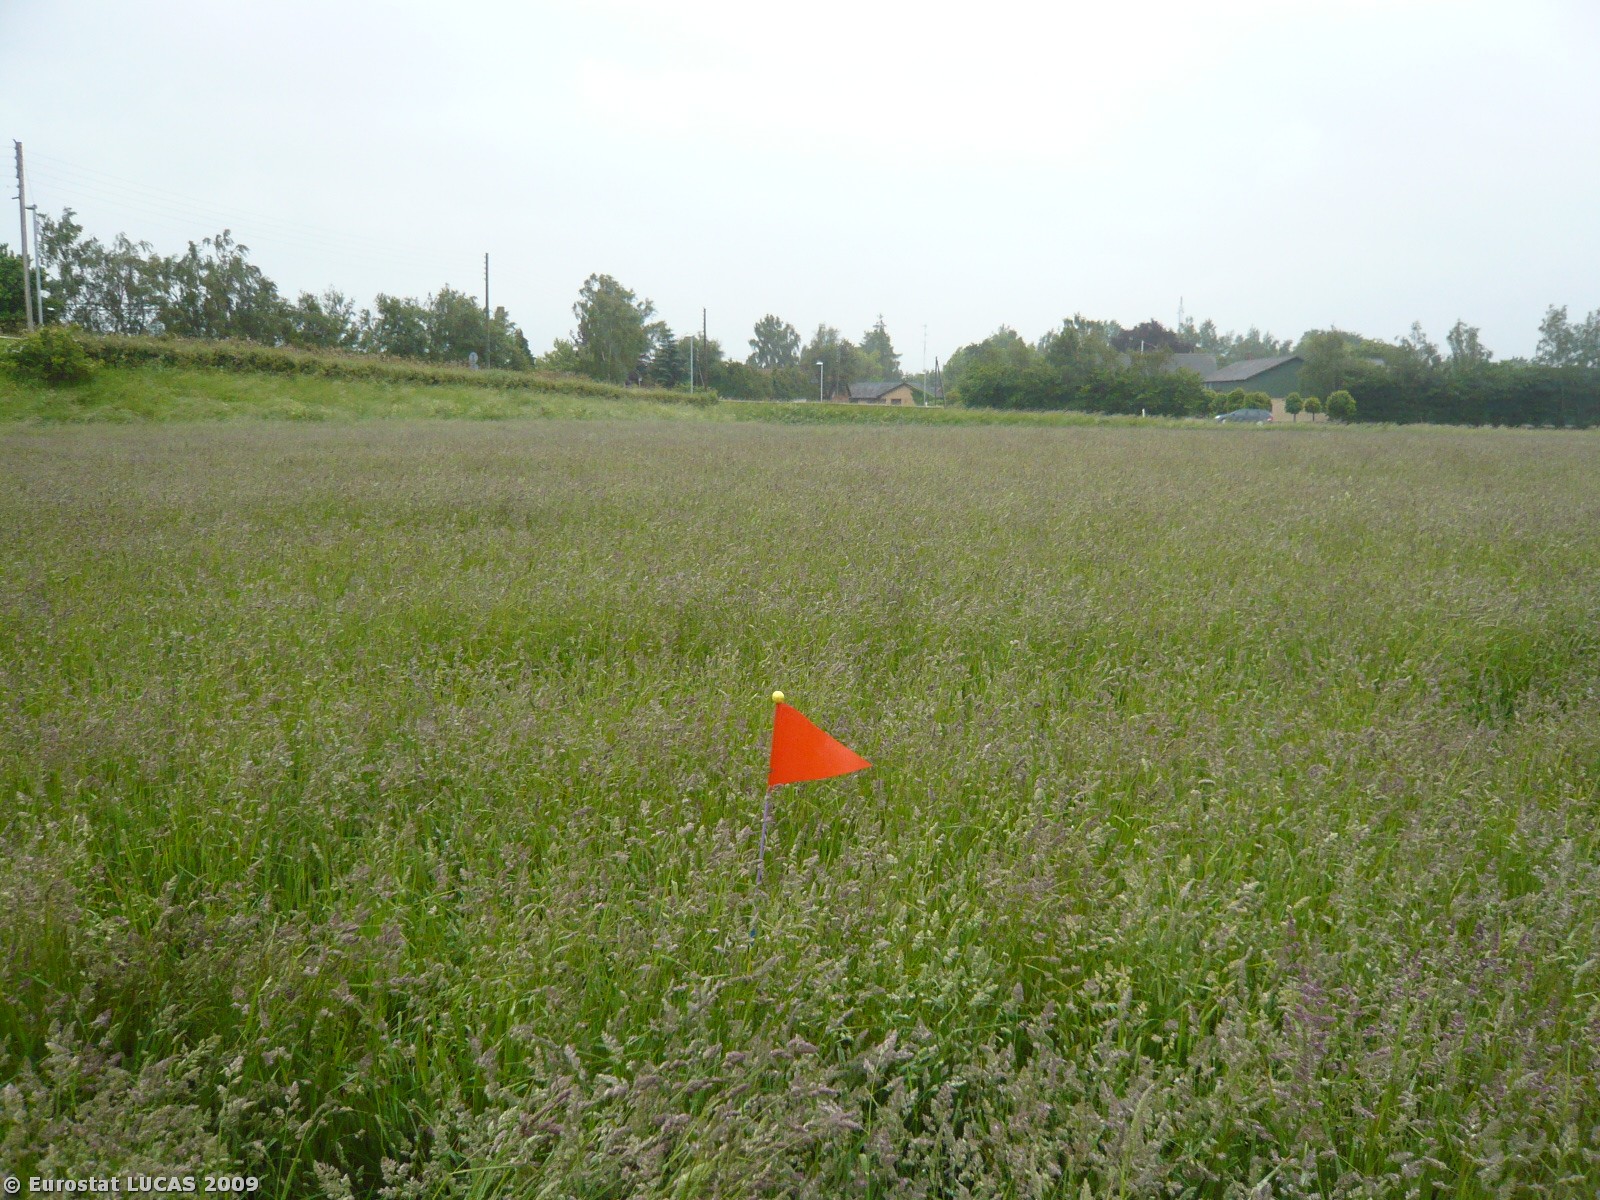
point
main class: Cropland
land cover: Temporary grasslands
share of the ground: > 75 %
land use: Agriculture (excluding fallow land and kitchen gardens)
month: June
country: DK
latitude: 54.8614
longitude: 11.8839
